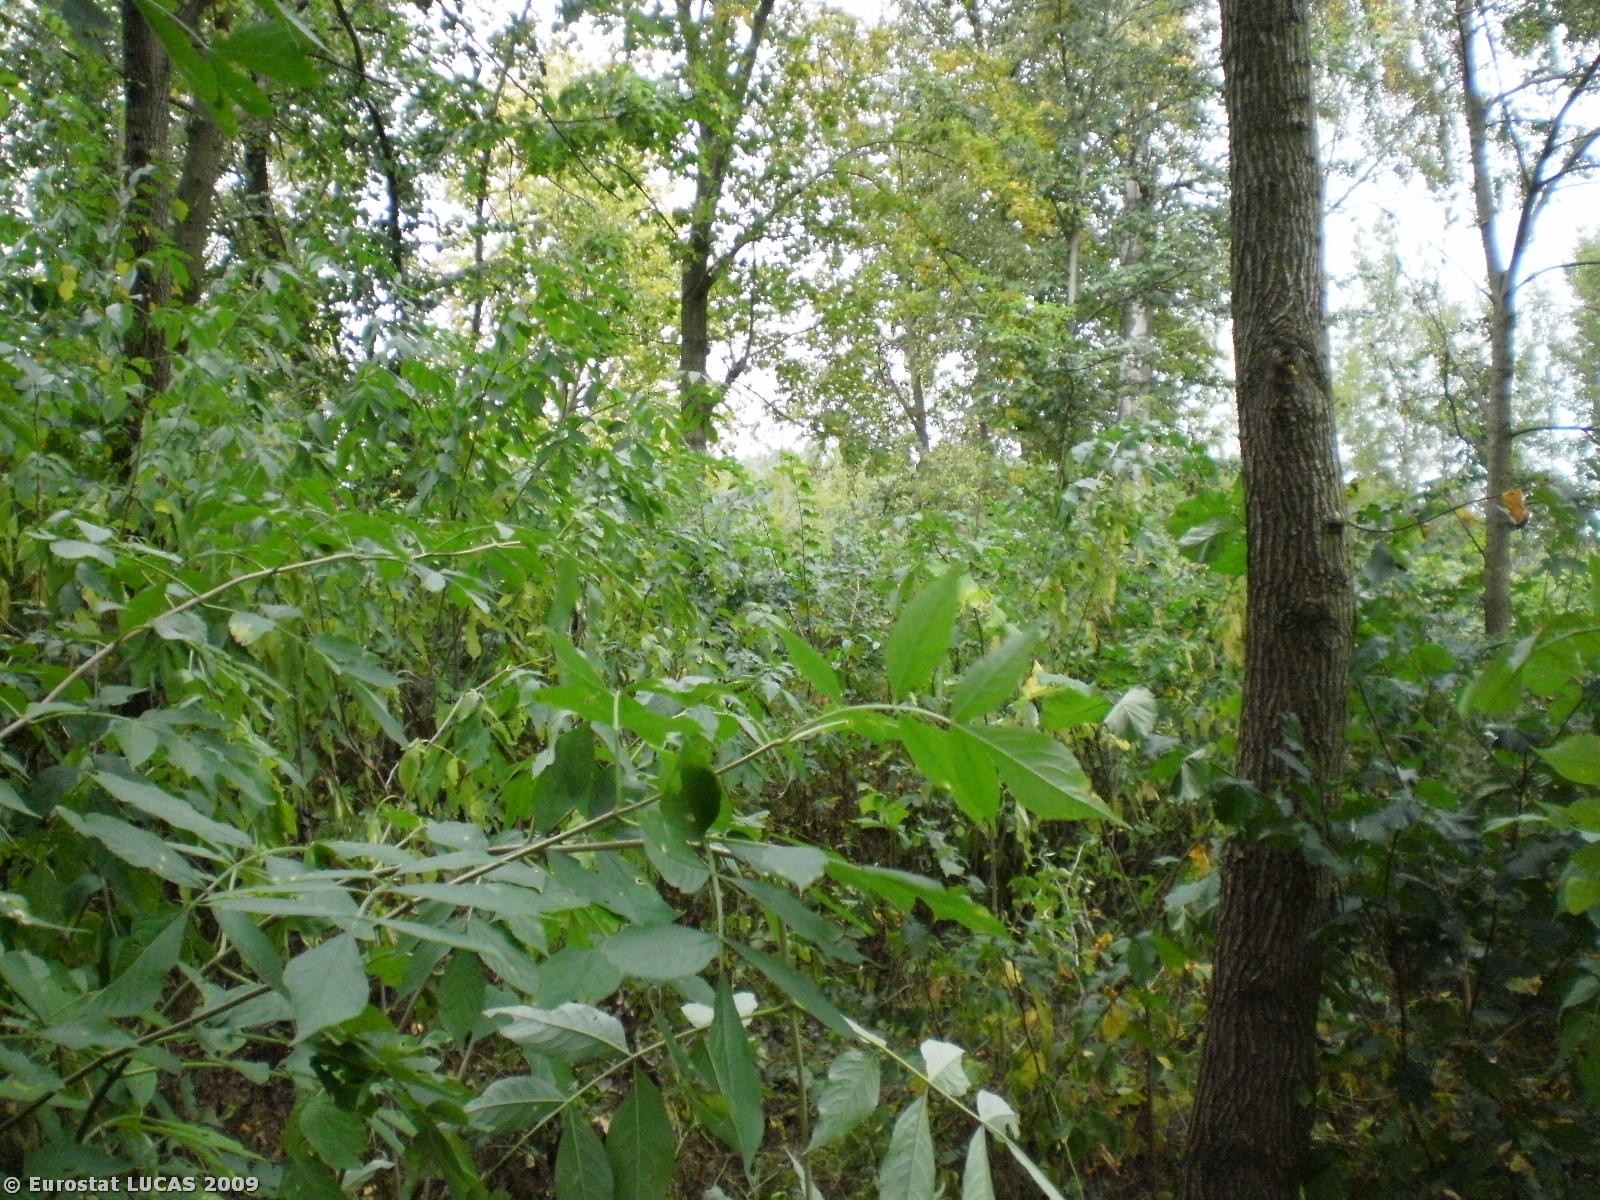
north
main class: Woodland
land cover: Broadleaved woodland
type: mesophytic deciduous forest
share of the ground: > 75 %
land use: Forestry
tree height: > 5 m
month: August
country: PL
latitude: 53.5339
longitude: 21.9609
